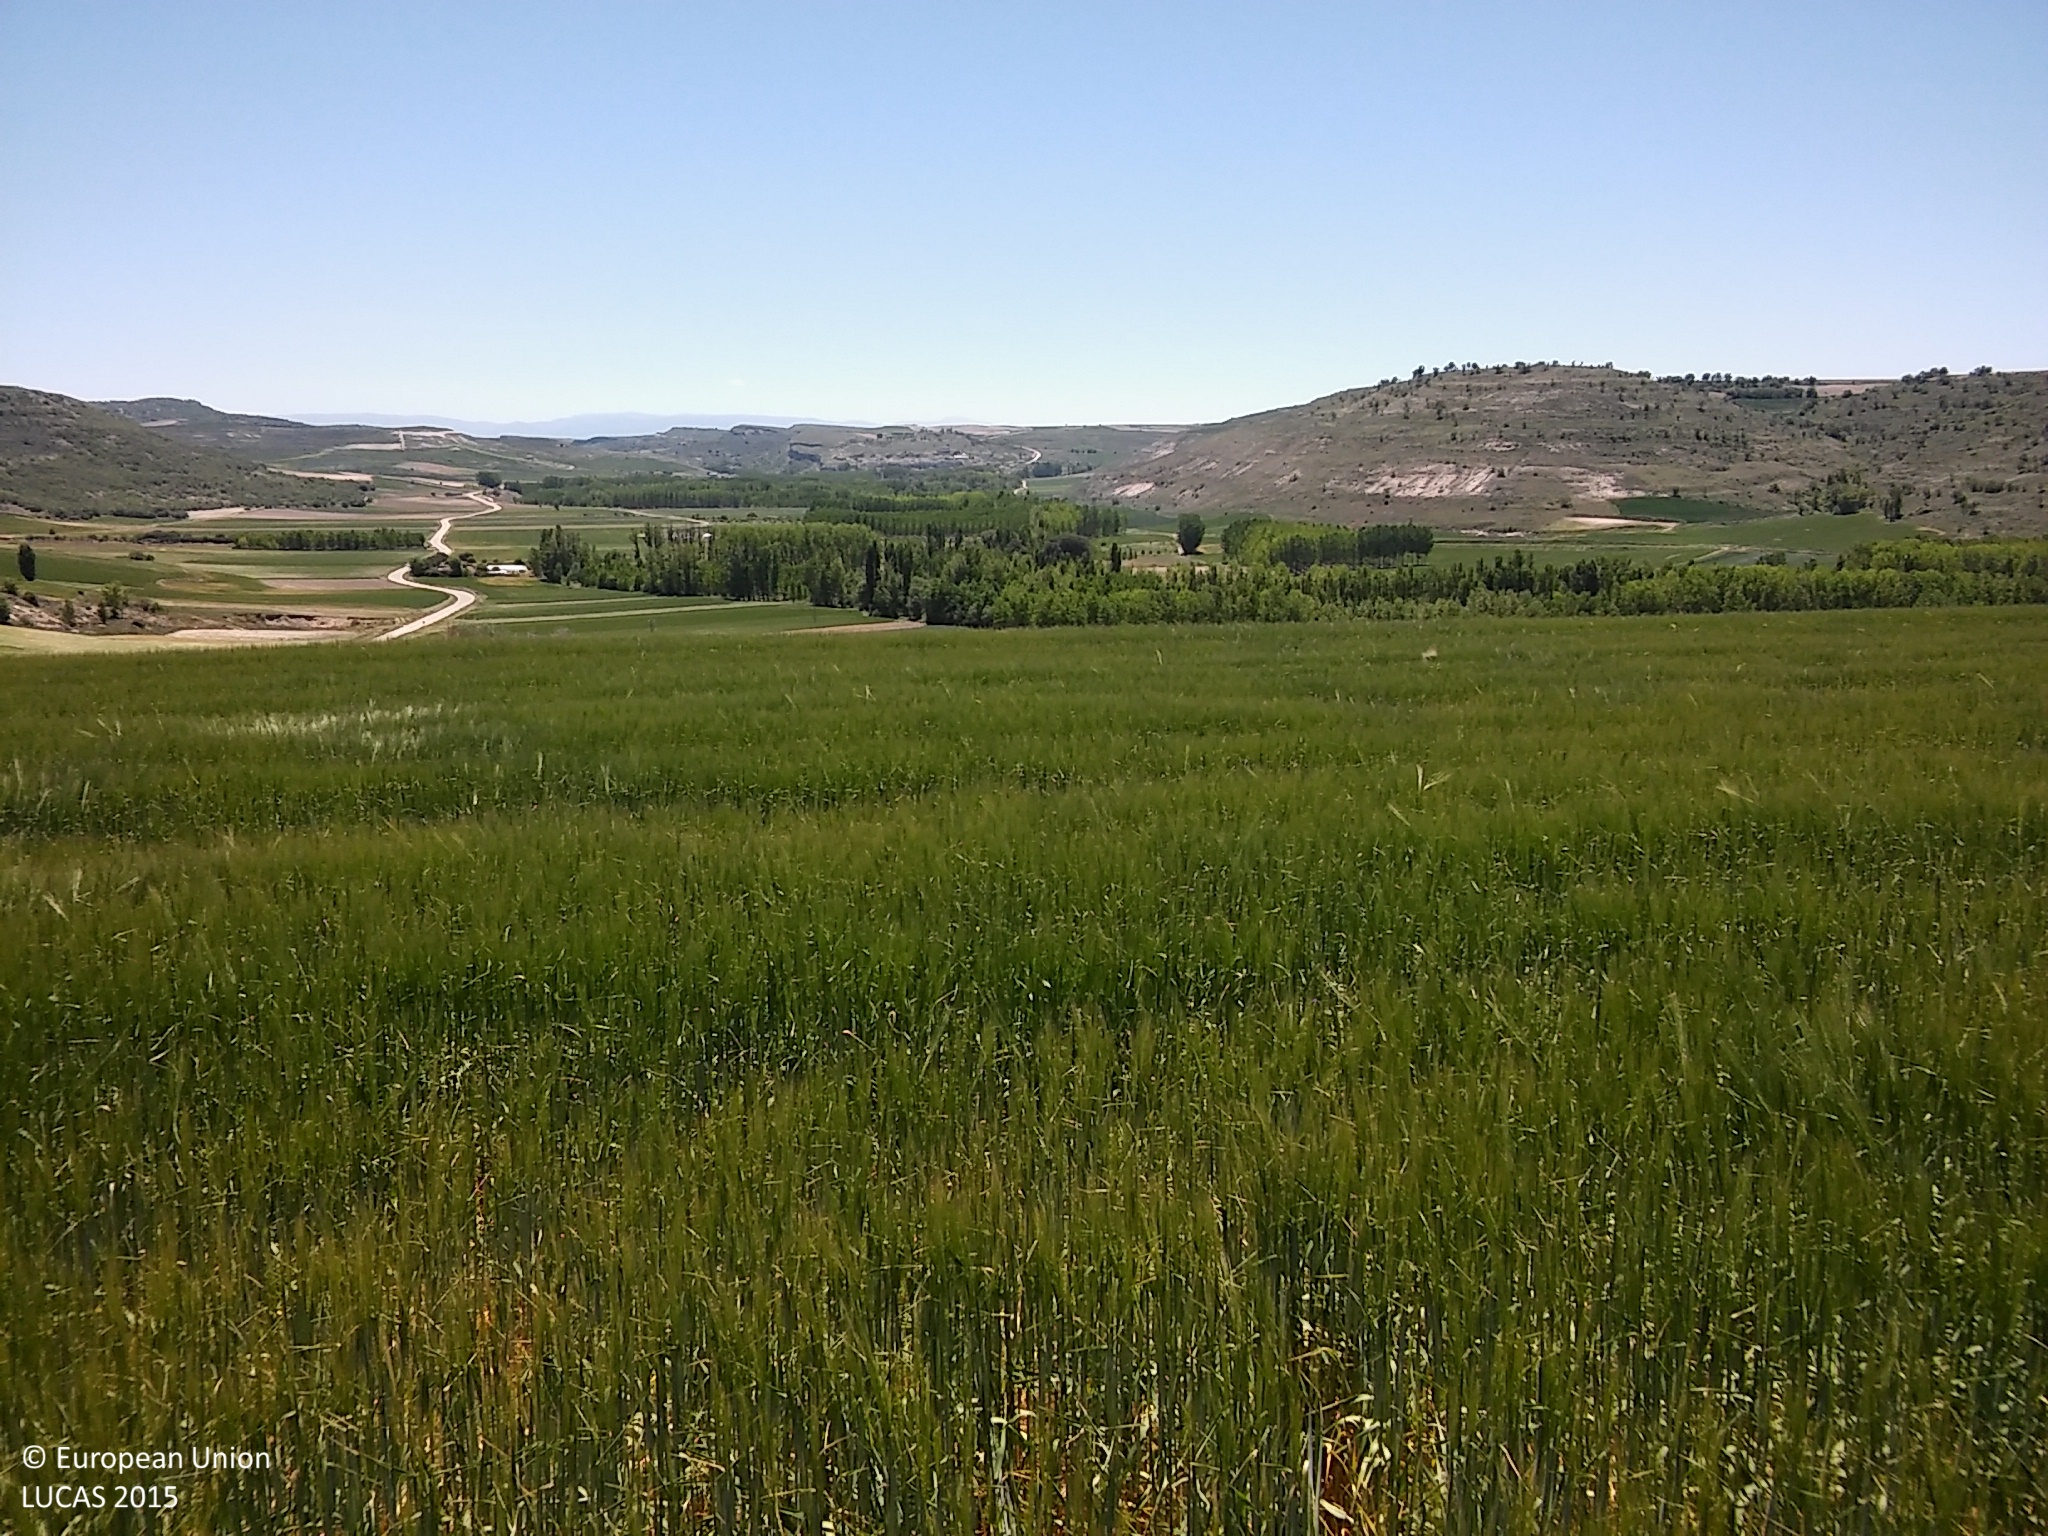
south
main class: Cropland
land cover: Barley
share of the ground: > 75 %
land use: Agriculture (excluding fallow land and kitchen gardens)
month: May
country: ES
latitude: 41.4774
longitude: -3.9821
